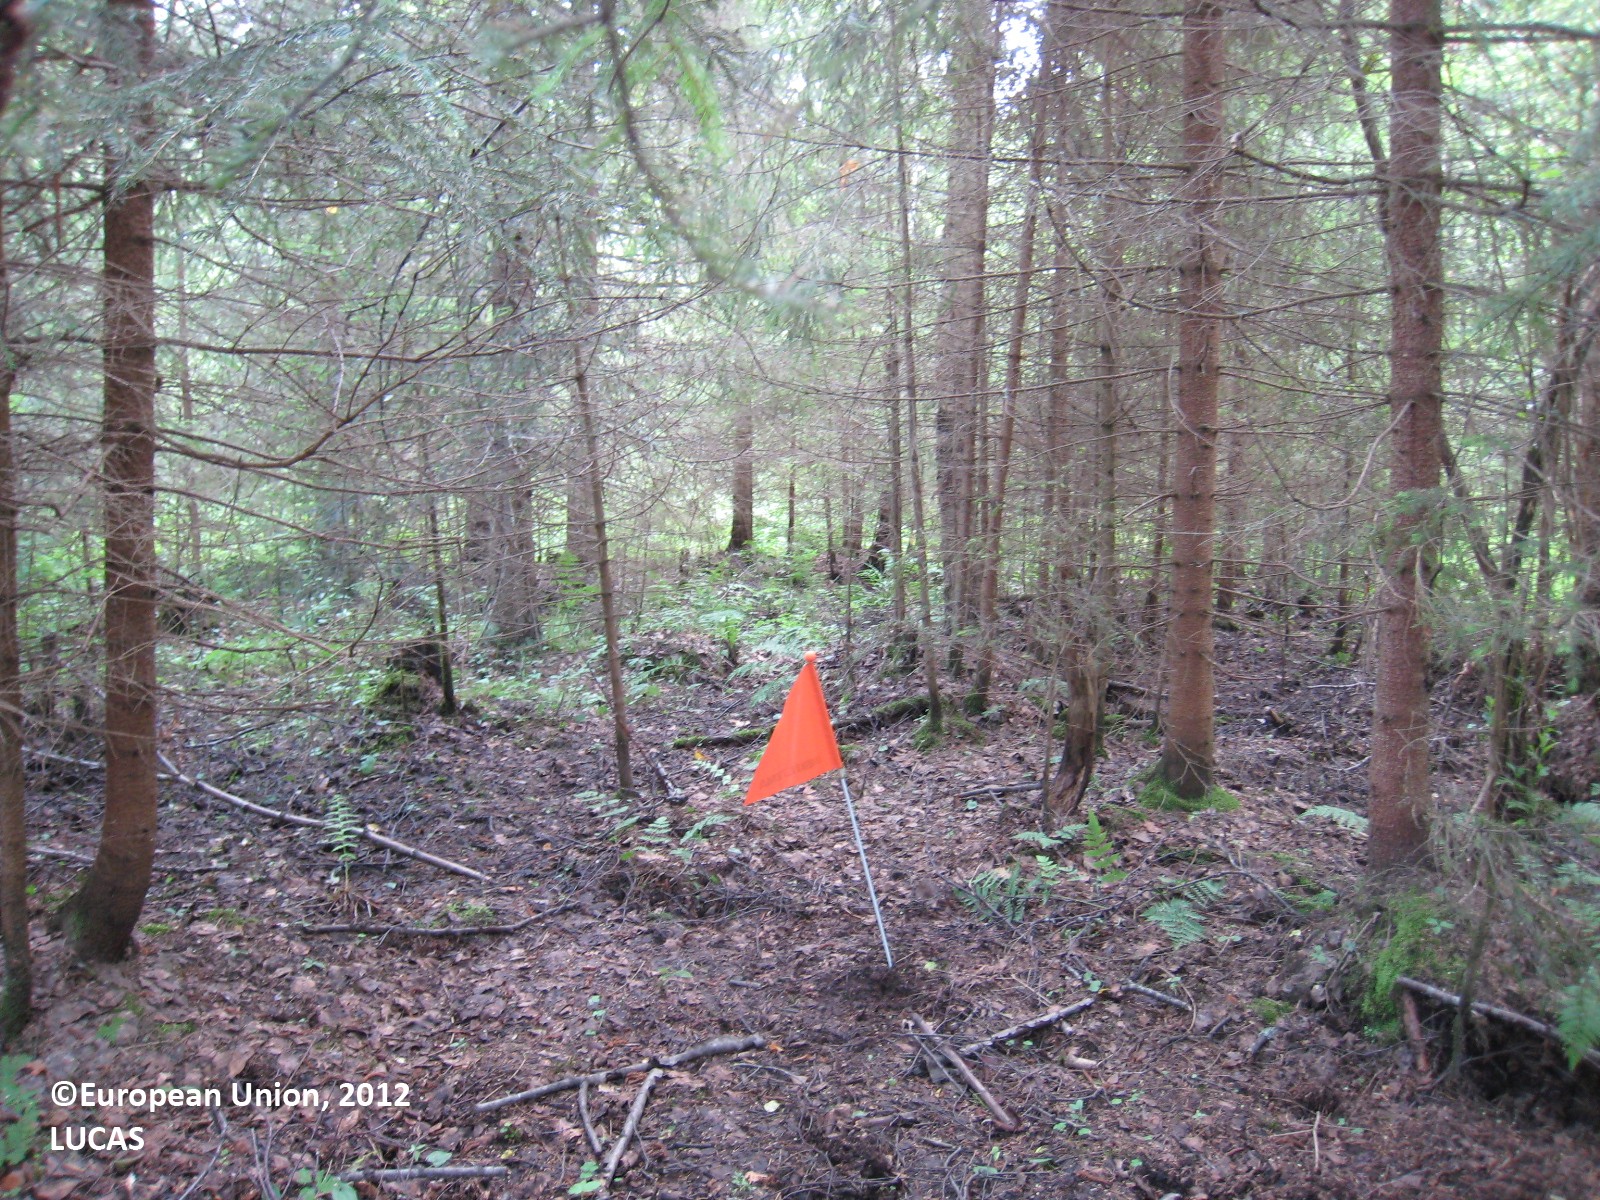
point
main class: Woodland
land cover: Spruce dominated mixed woodland
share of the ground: > 75 %
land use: Forestry
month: July
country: FI
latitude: 61.8981
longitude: 27.1177
